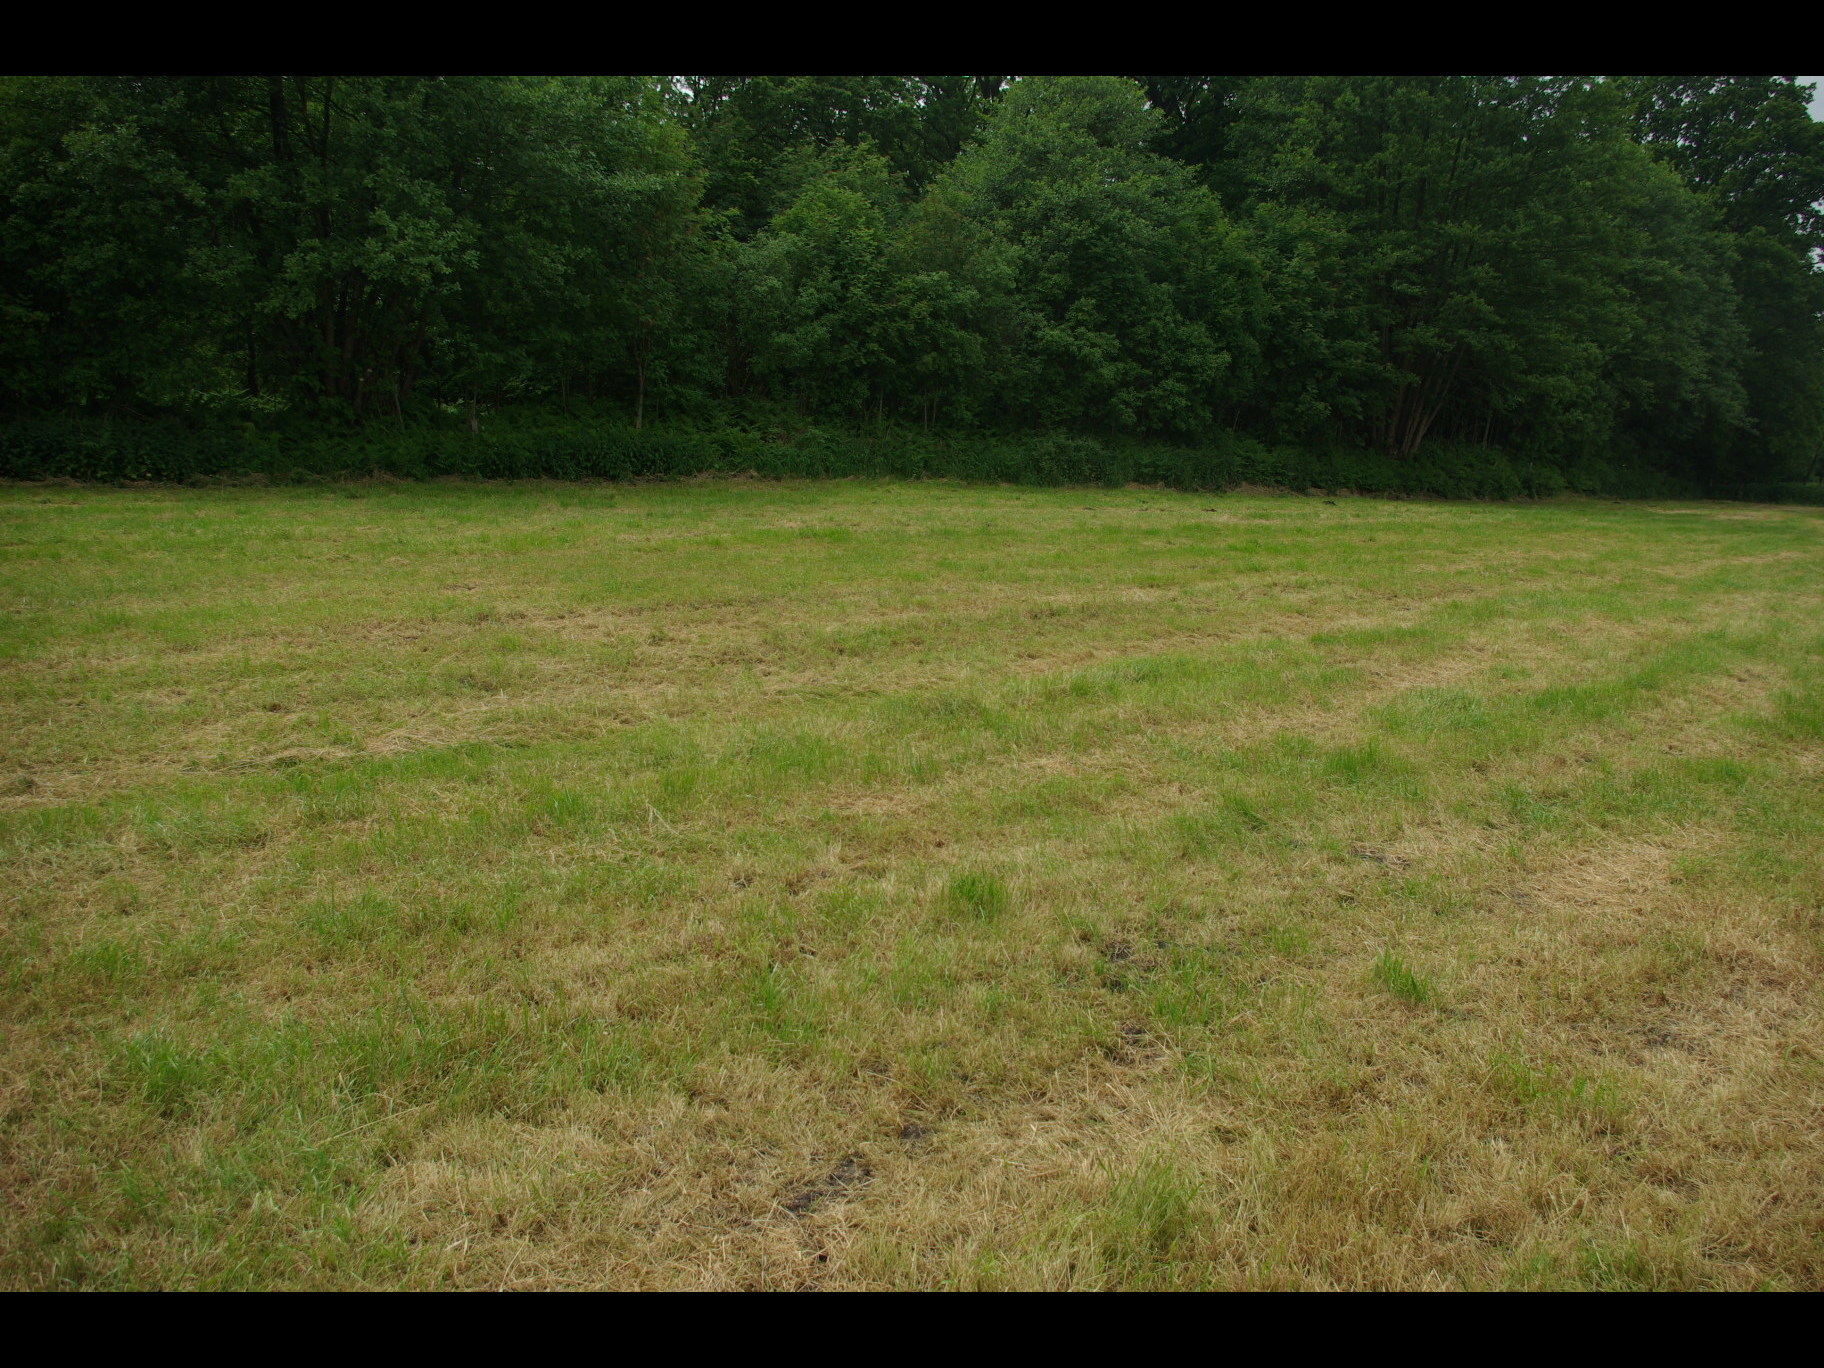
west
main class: Grassland
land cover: Grassland without tree/shrub cover
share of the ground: > 75 %
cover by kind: herbaceous plants 100 %
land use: Agriculture (excluding fallow land and kitchen gardens)
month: June
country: DE
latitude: 54.4083
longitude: 9.8922
